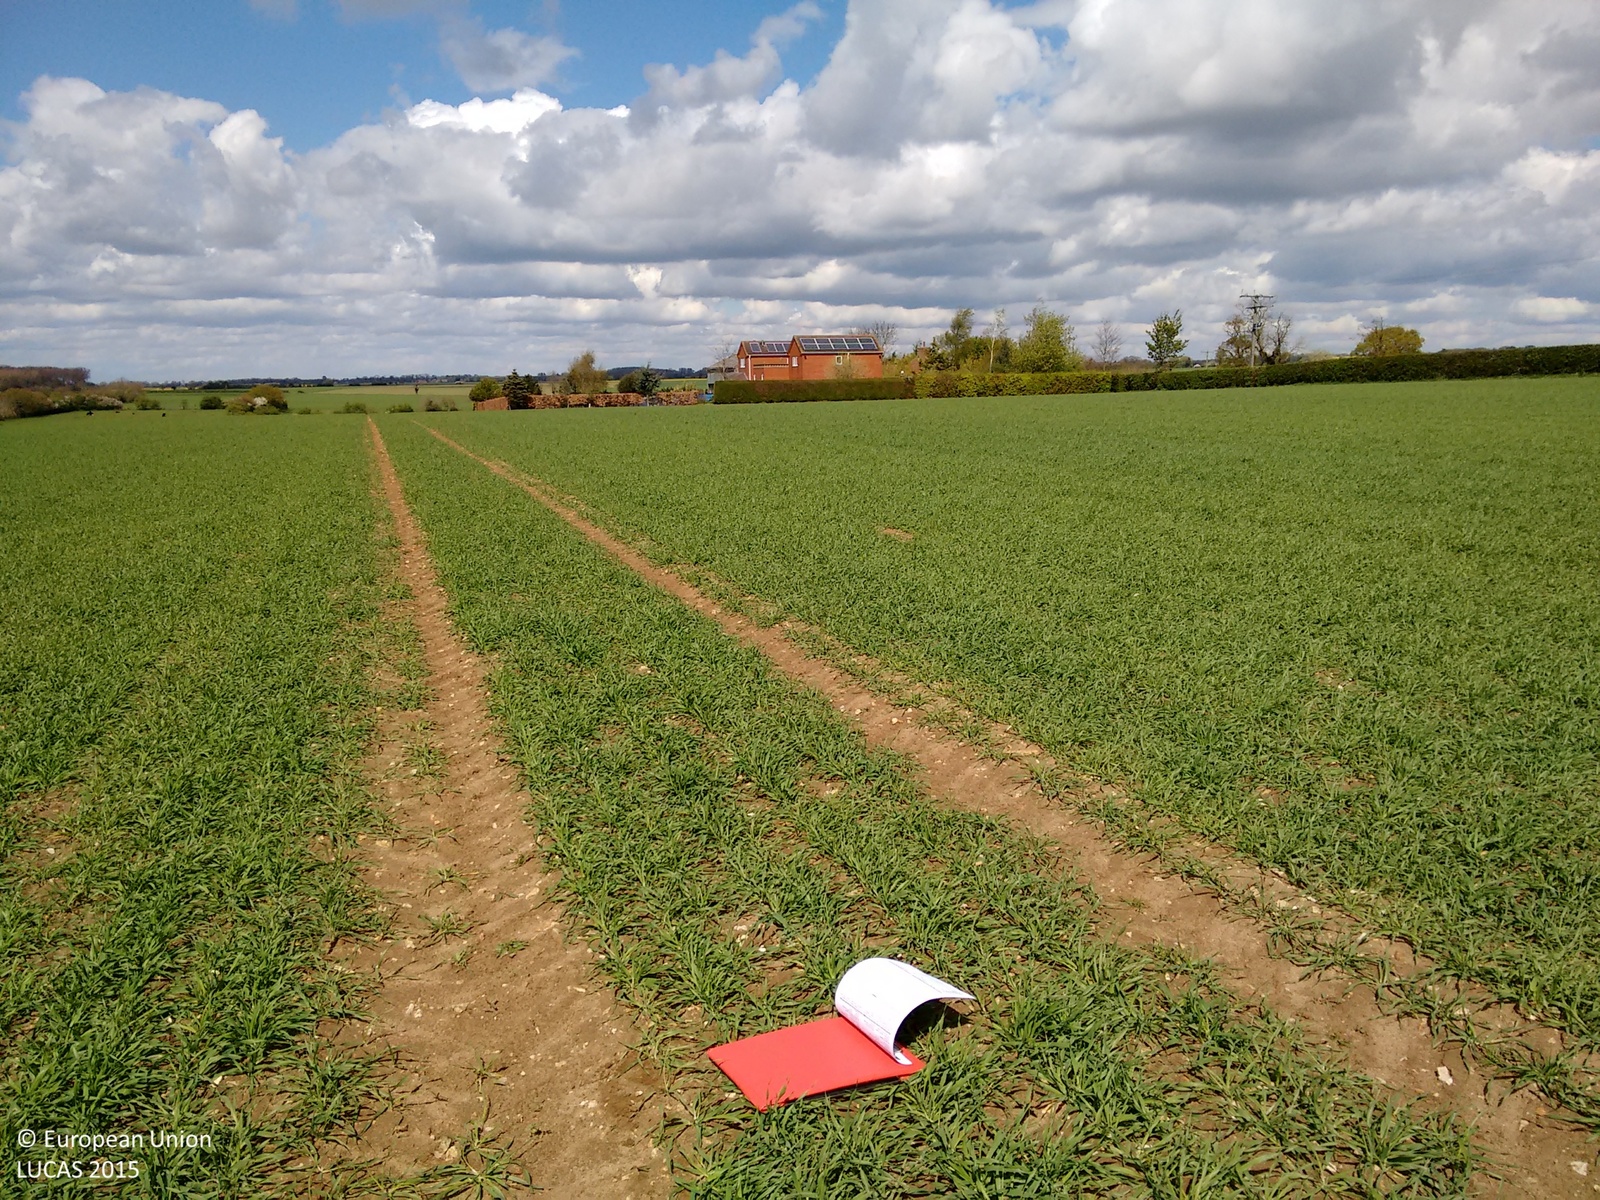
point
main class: Cropland
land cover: Barley
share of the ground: 50 - 75 %
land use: Agriculture (excluding fallow land and kitchen gardens)
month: April
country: GB
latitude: 53.1422
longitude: -0.0943
